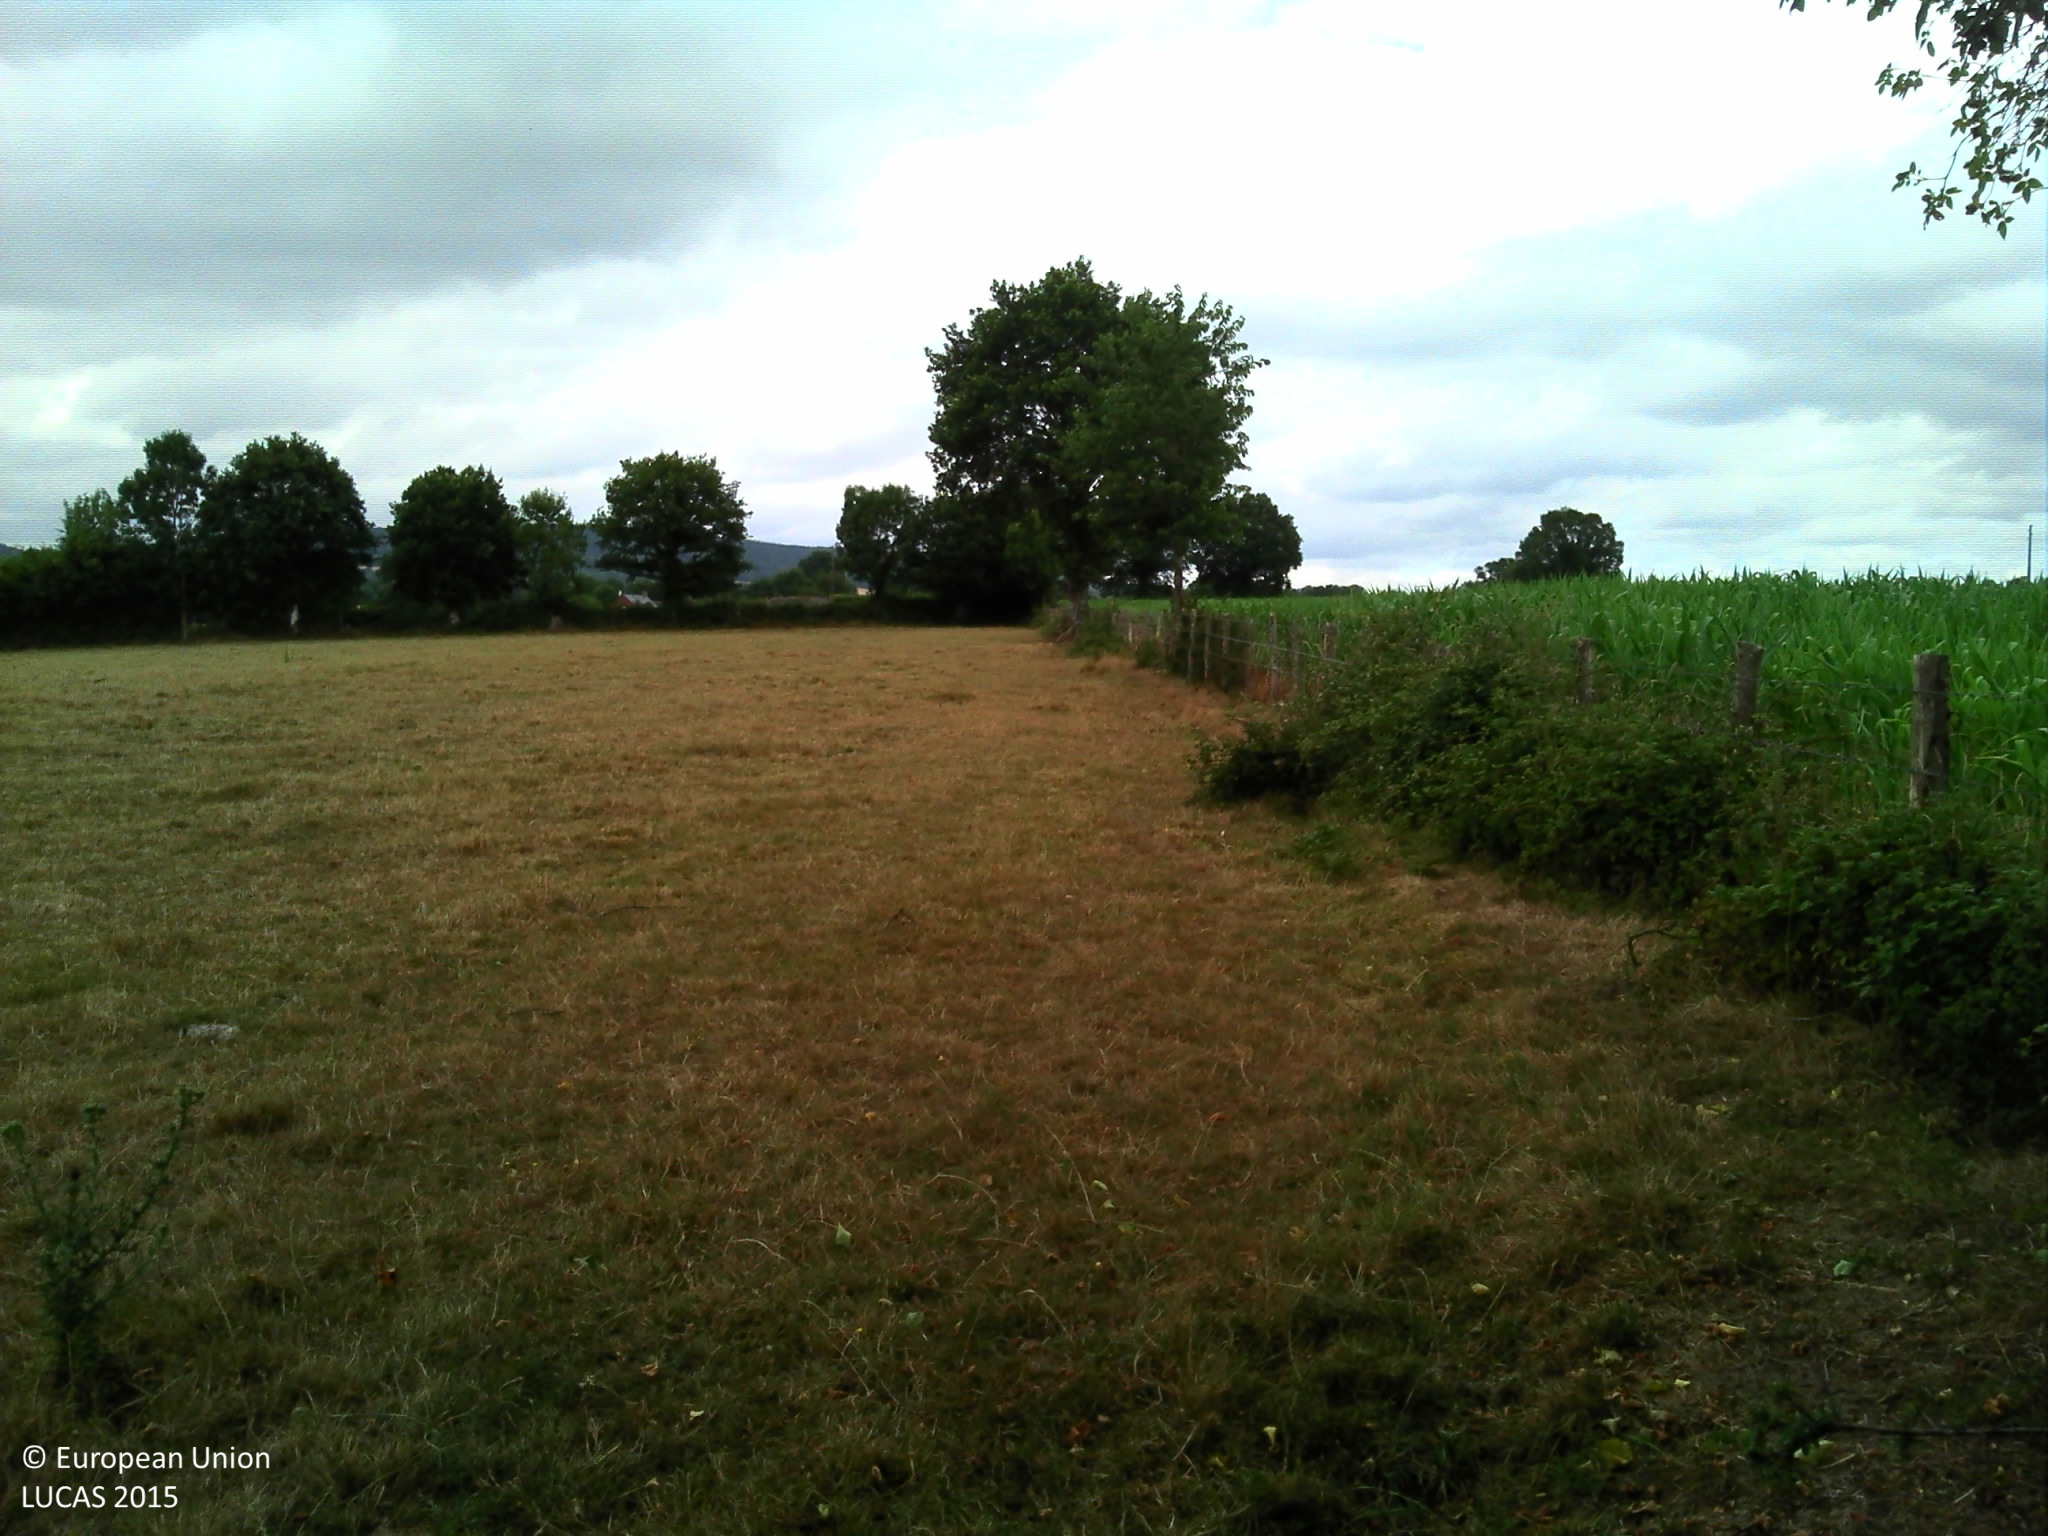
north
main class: Grassland
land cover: Grassland without tree/shrub cover
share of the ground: > 75 %
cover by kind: herbaceous plants 100 %
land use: Agriculture (excluding fallow land and kitchen gardens)
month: July
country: FR
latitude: 48.4117
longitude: -0.0954
